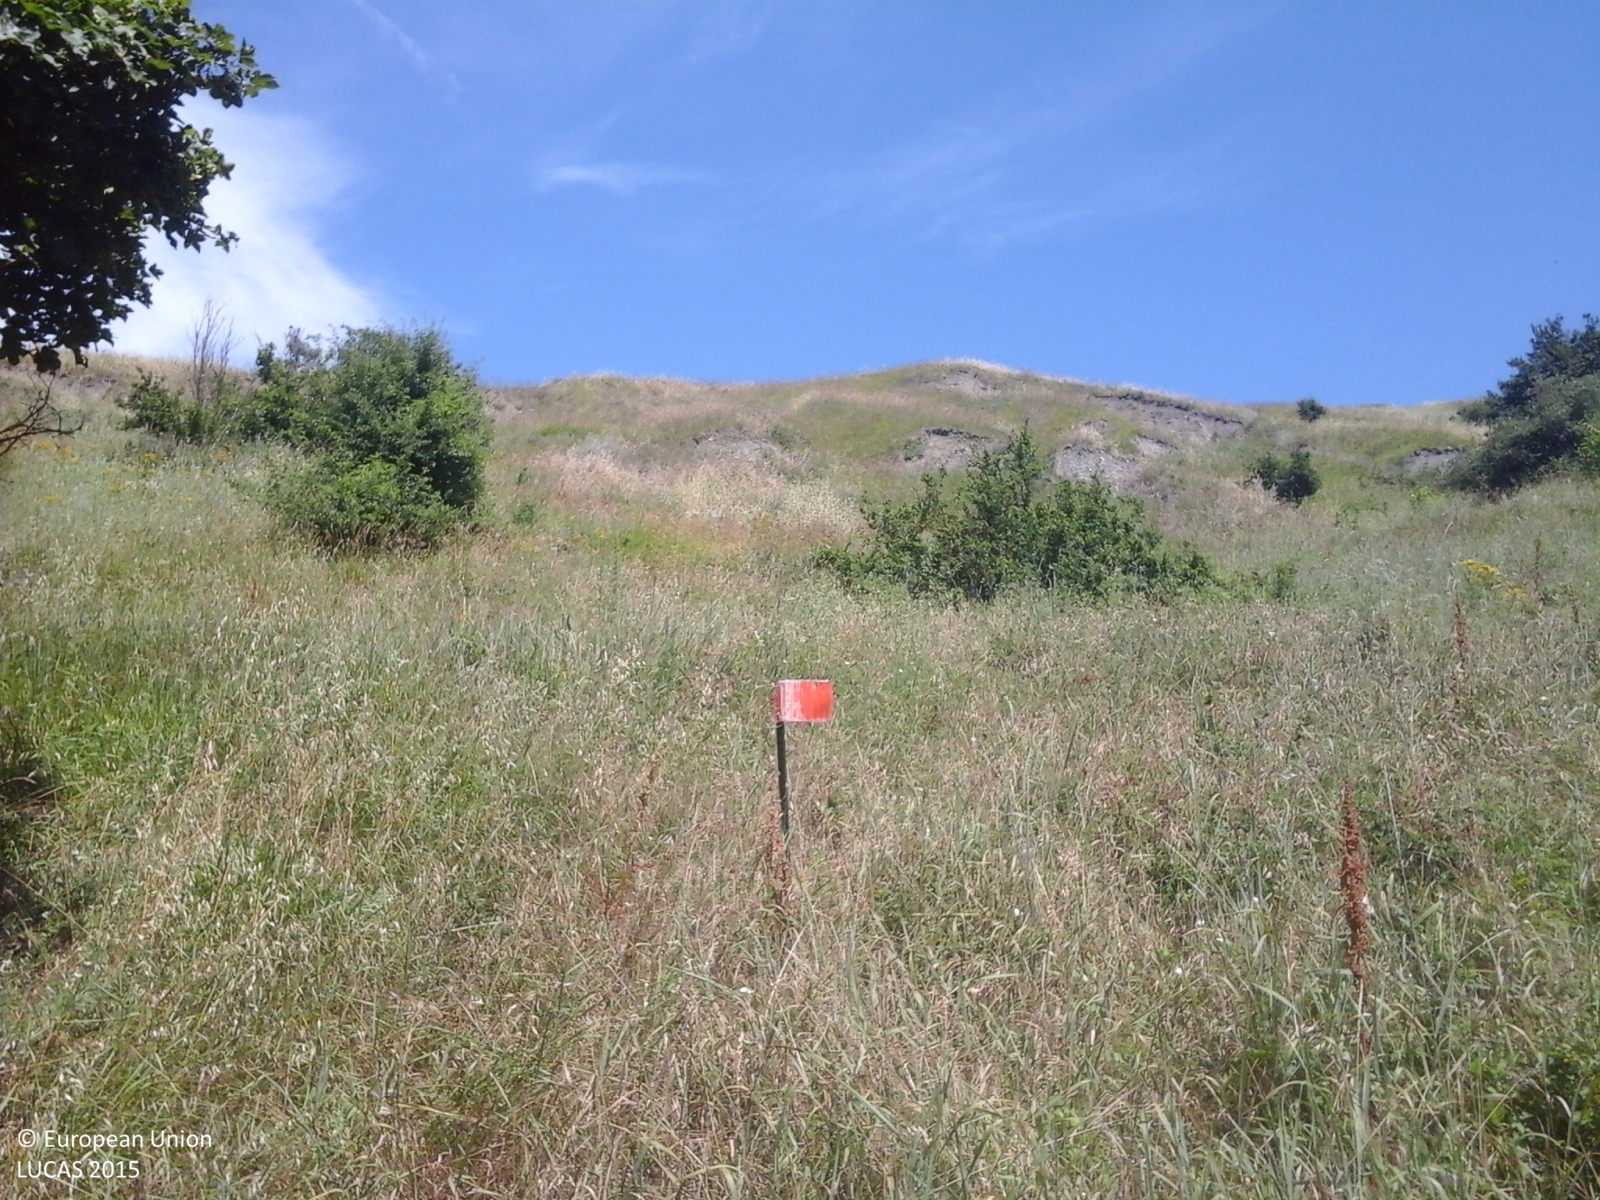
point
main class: Grassland
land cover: Grassland with sparse tree/shrub cover
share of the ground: > 75 %
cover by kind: herbaceous plants 90 %, broadleaved forest trees 5 %, shrubs 5 %
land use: Semi-natural and natural areas not in use
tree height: > 5 m
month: June
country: IT
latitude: 44.4929
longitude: 10.6399
